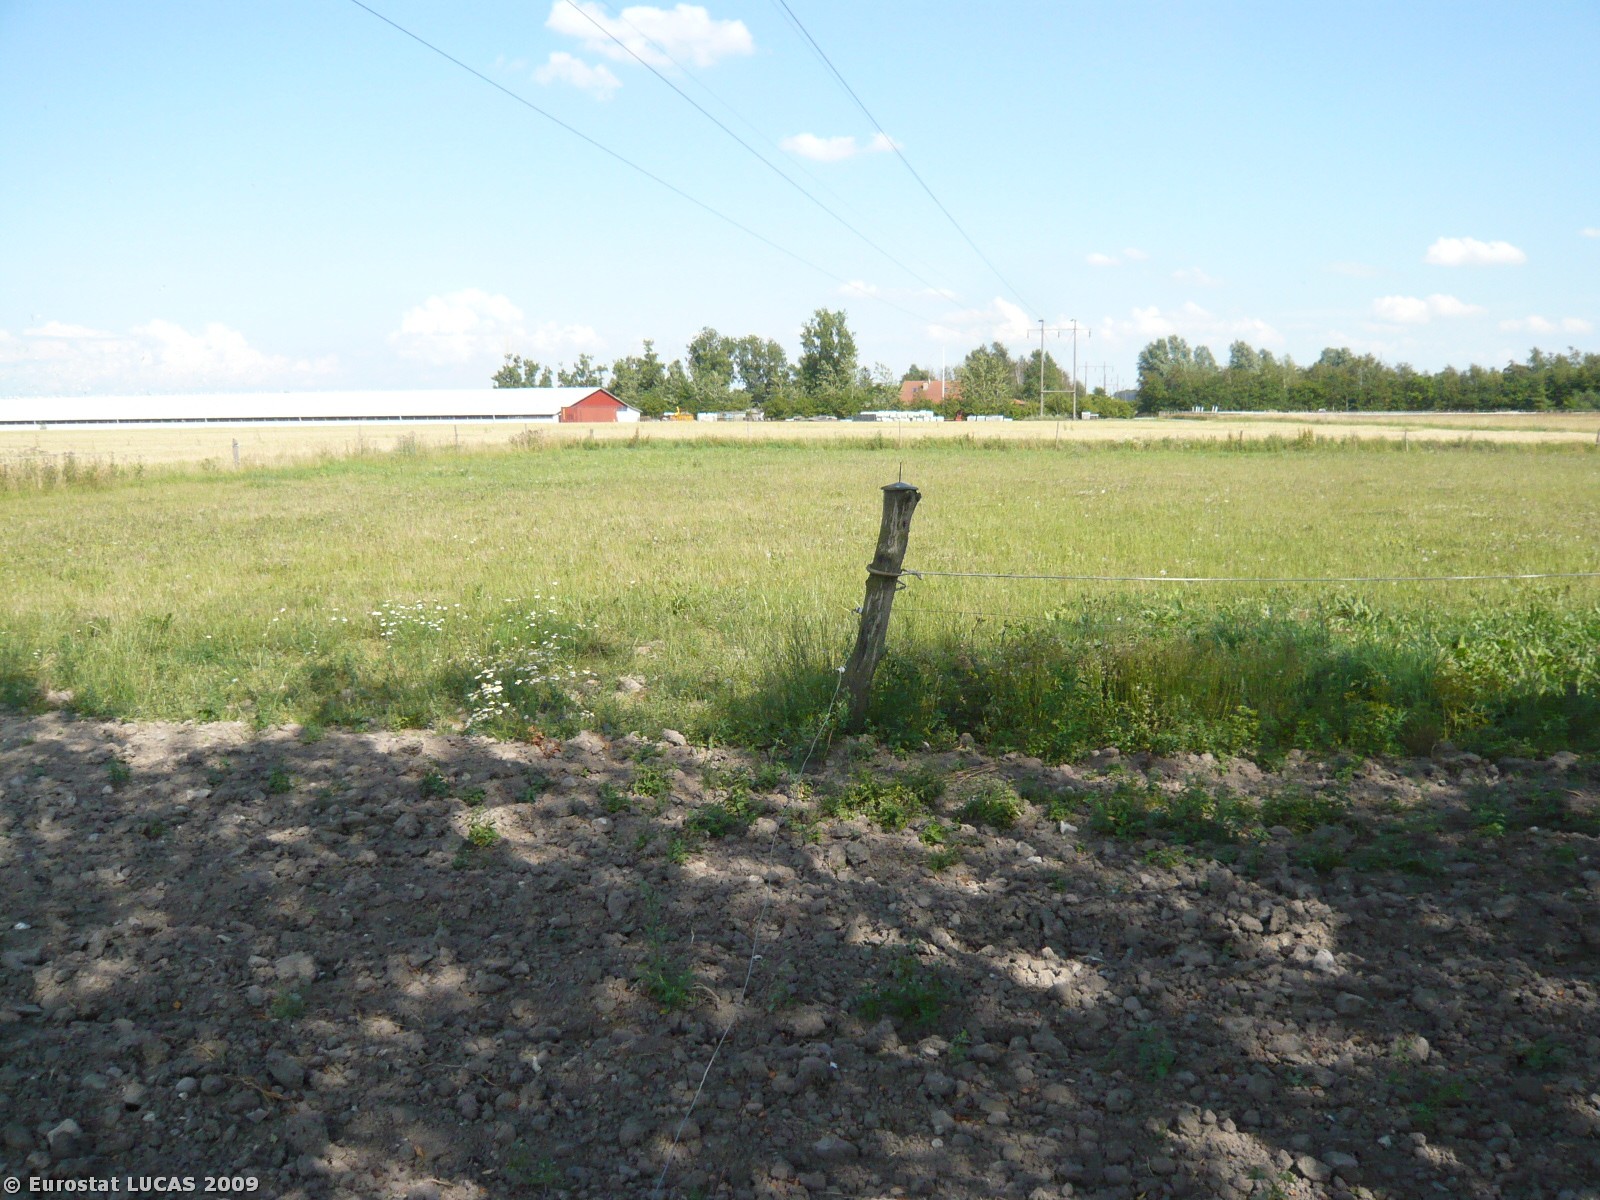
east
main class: Cropland
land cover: Barley
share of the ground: > 75 %
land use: Agriculture (excluding fallow land and kitchen gardens)
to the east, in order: Barley; Grassland without tree/shrub cover
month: July
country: DK
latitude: 55.7301
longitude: 11.4477
